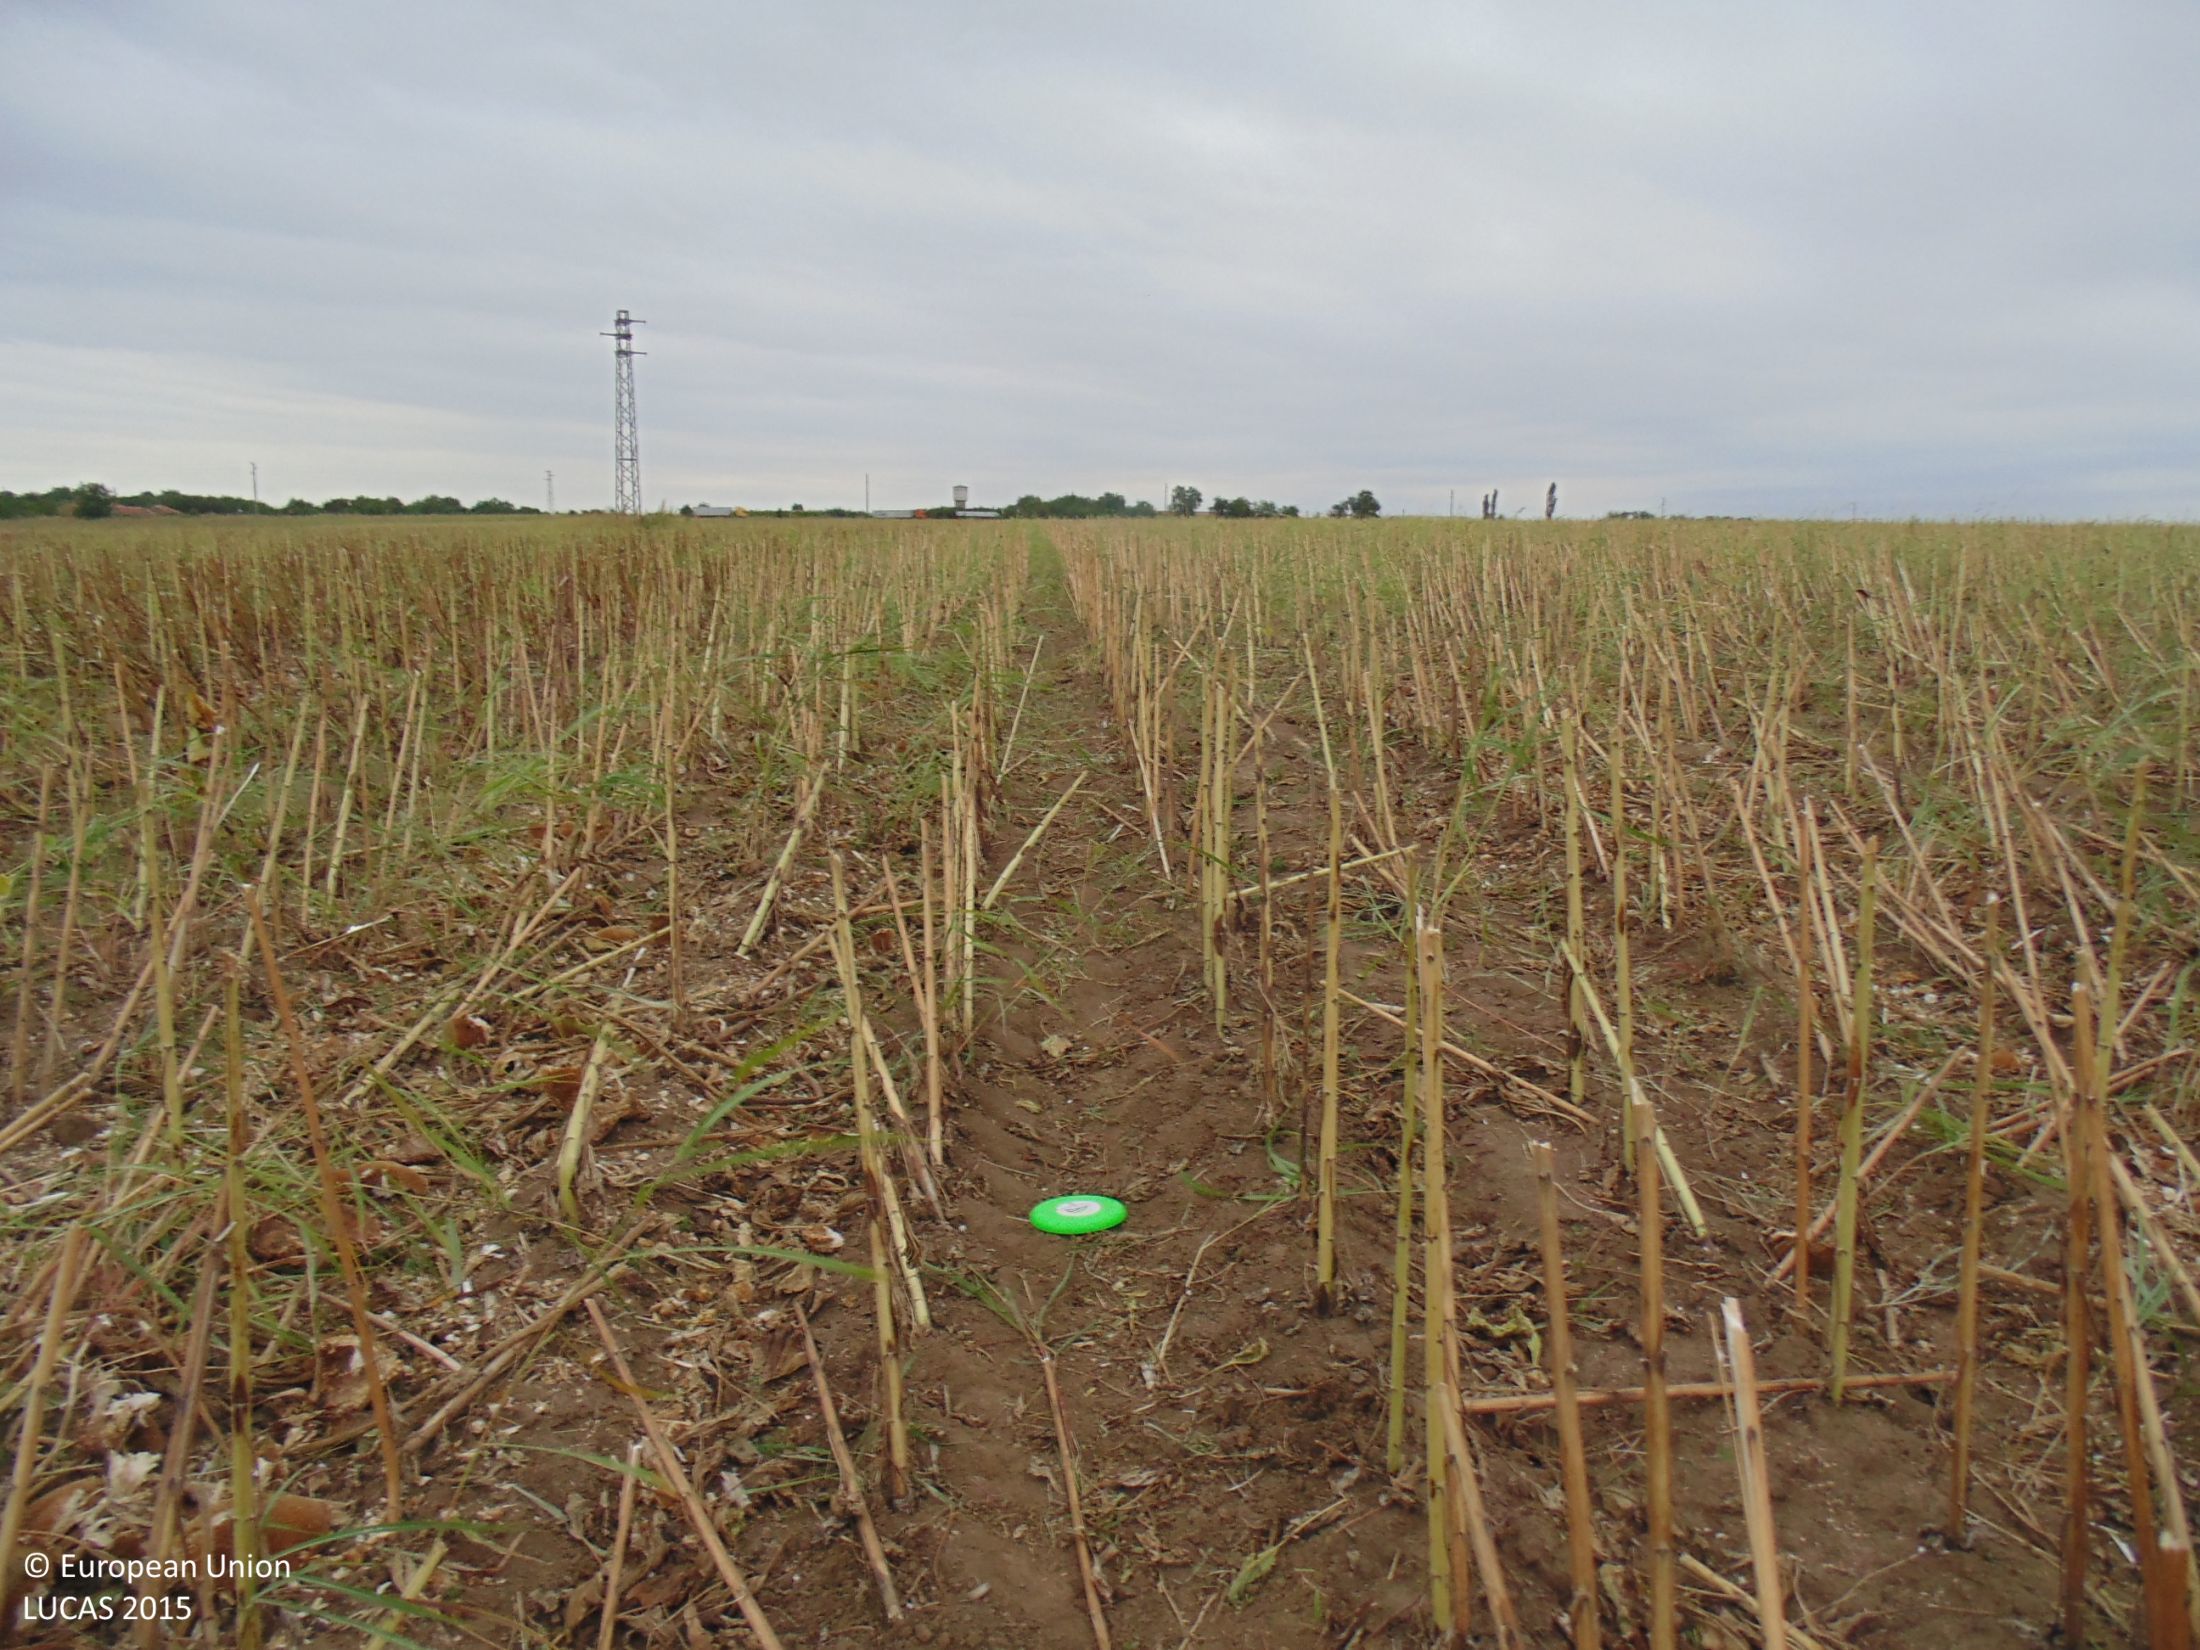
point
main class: Cropland
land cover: Sunflower
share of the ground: 10 - 25 %
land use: Agriculture (excluding fallow land and kitchen gardens)
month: September
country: BG
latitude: 44.0232
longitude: 26.8752
